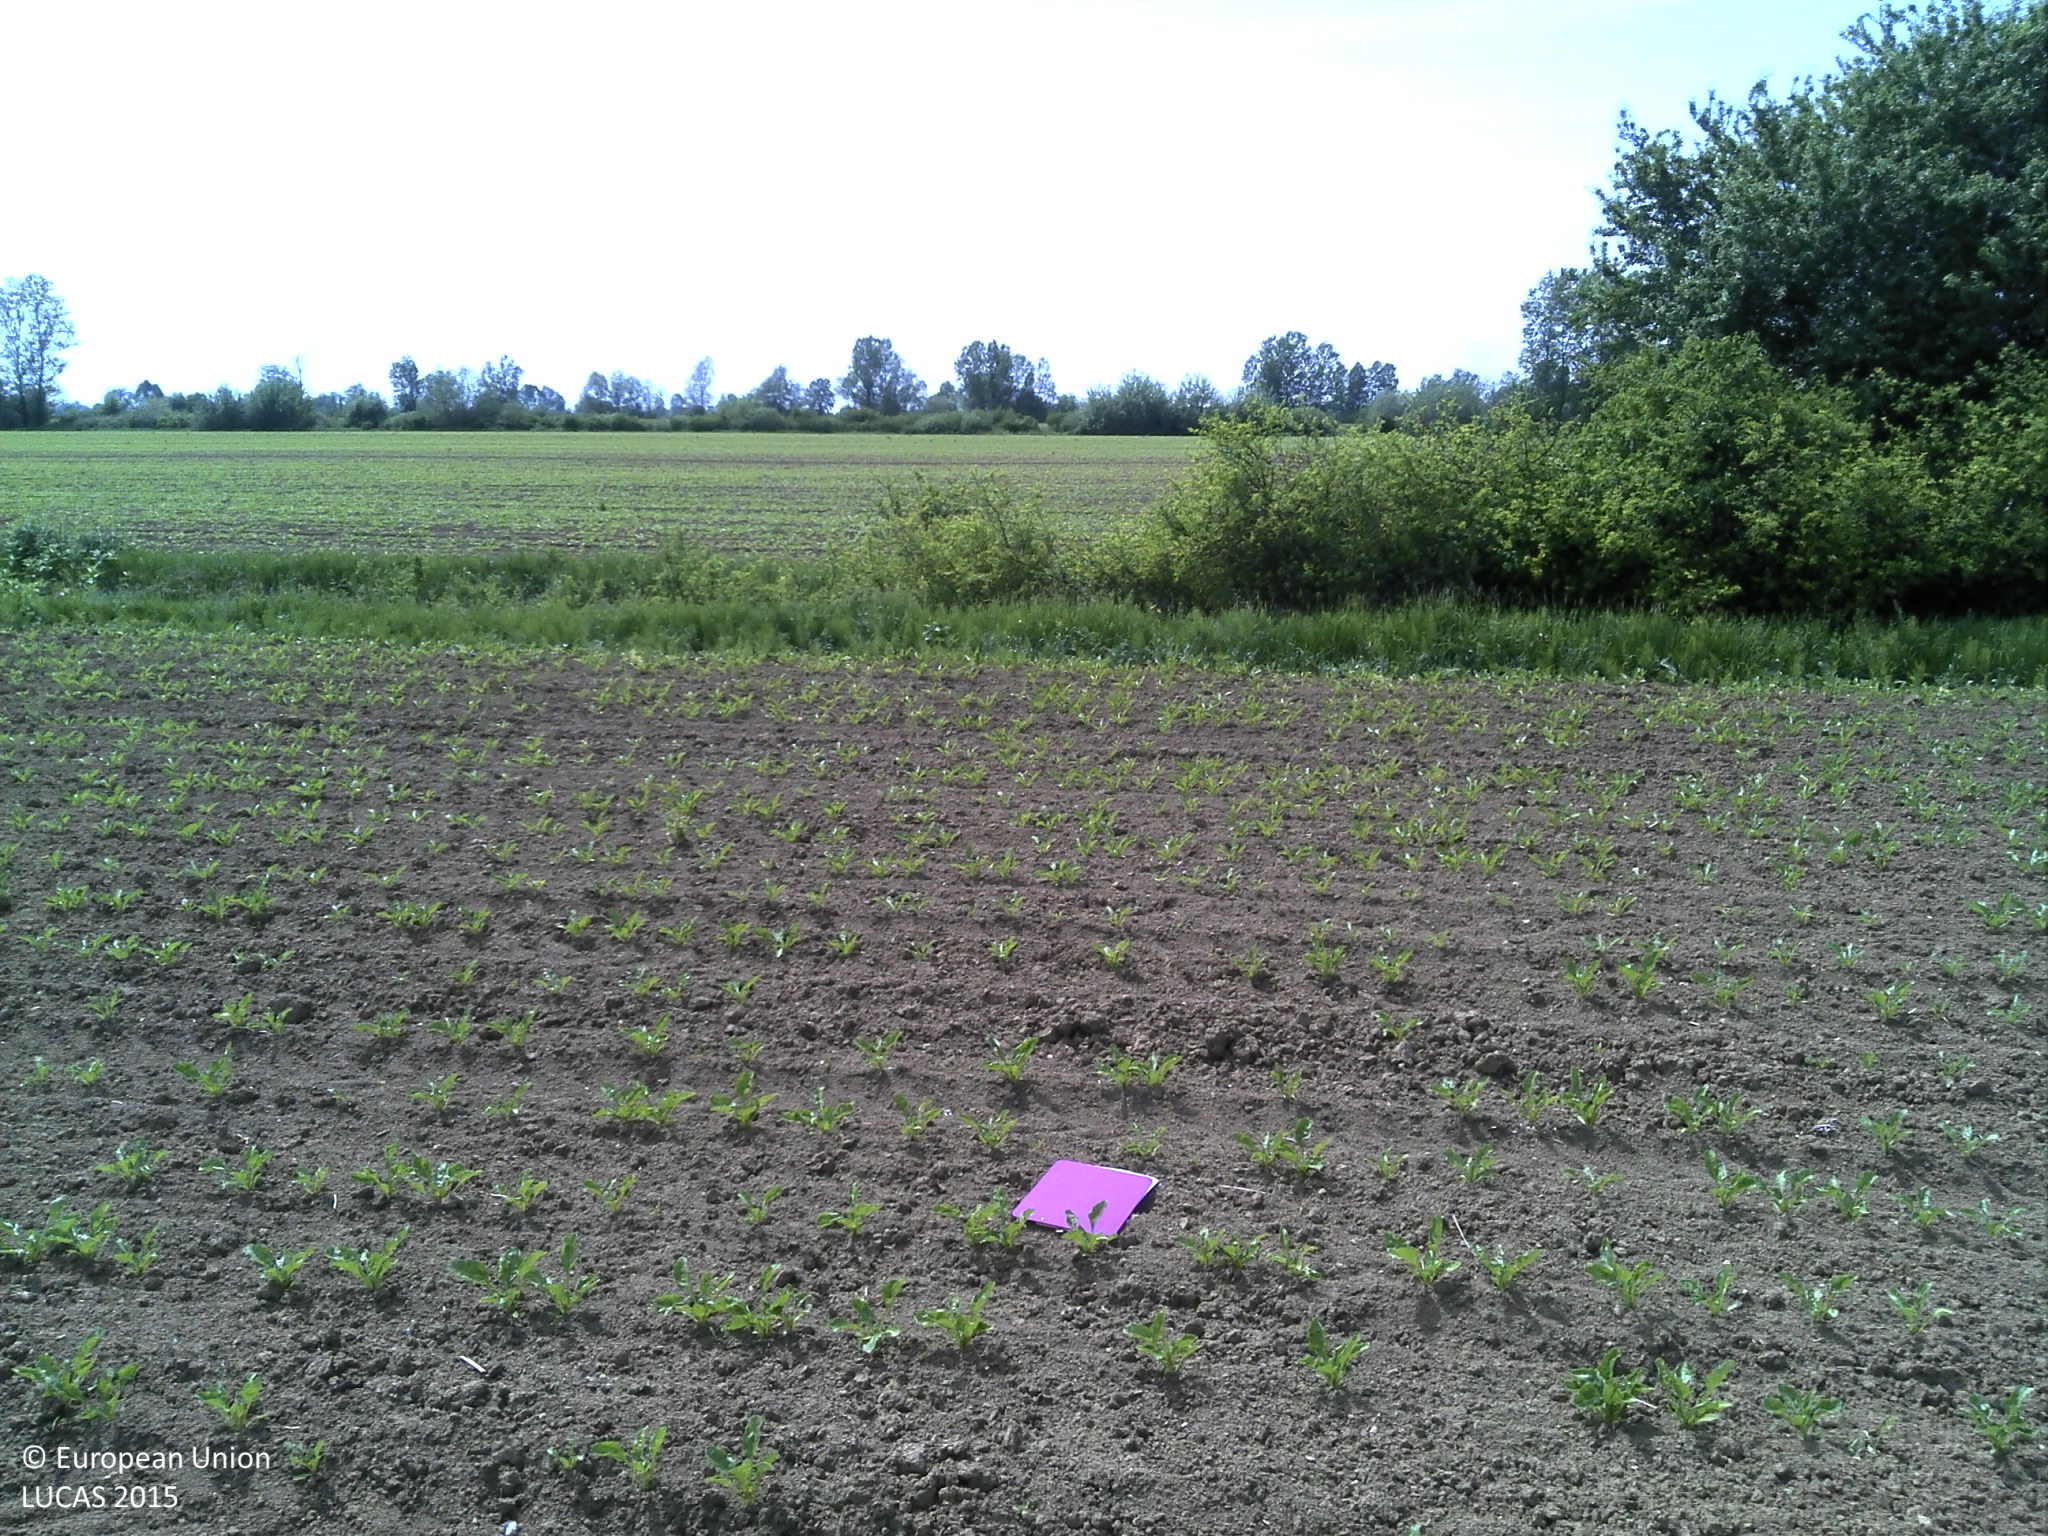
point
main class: Cropland
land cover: Sugar beet
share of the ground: < 10 %
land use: Agriculture (excluding fallow land and kitchen gardens)
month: May
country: HR
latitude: 45.1977
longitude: 18.4958
